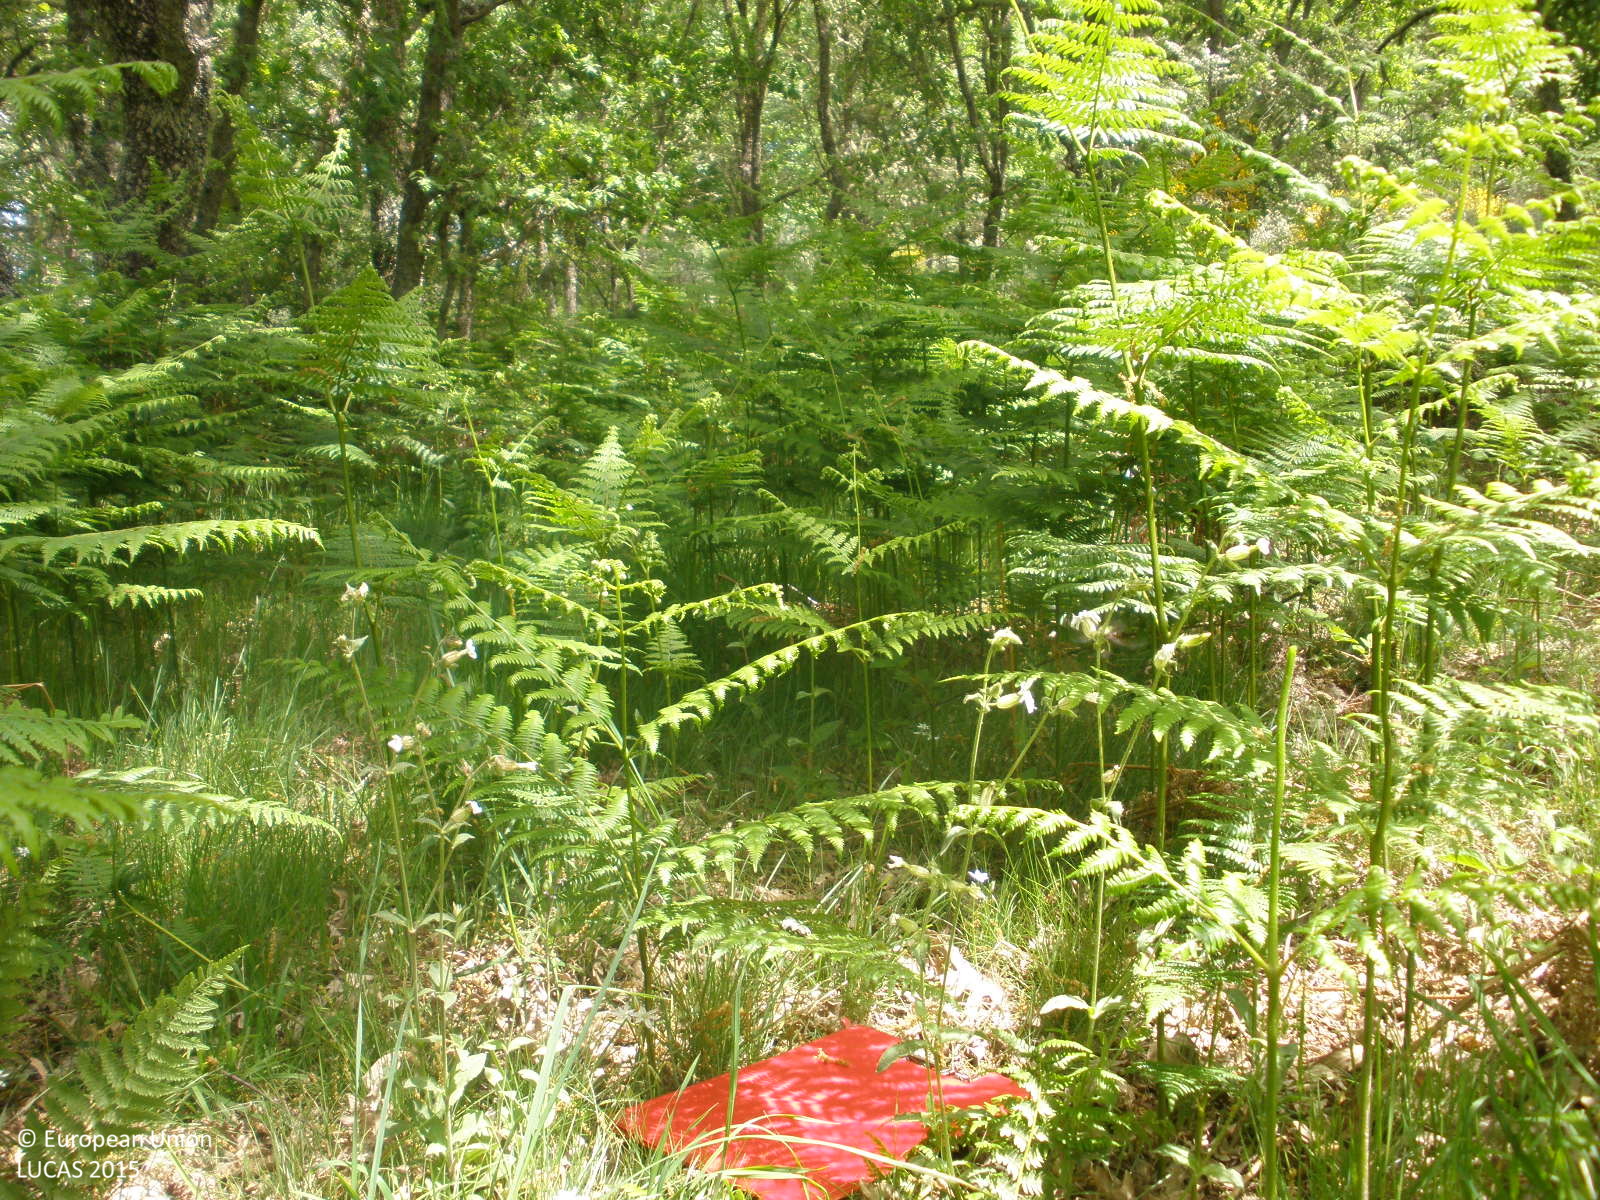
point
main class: Woodland
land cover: Broadleaved woodland
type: thermophilous deciduous forest
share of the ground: > 75 %
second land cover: Grassland without tree/shrub cover
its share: > 75 %
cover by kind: broadleaved forest trees 80 %, shrubs 10 %, herbaceous plants 10 %
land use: Forestry
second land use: Agriculture (excluding fallow land and kitchen gardens)
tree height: > 5 m
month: May
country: ES
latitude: 40.3084
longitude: -6.6429
